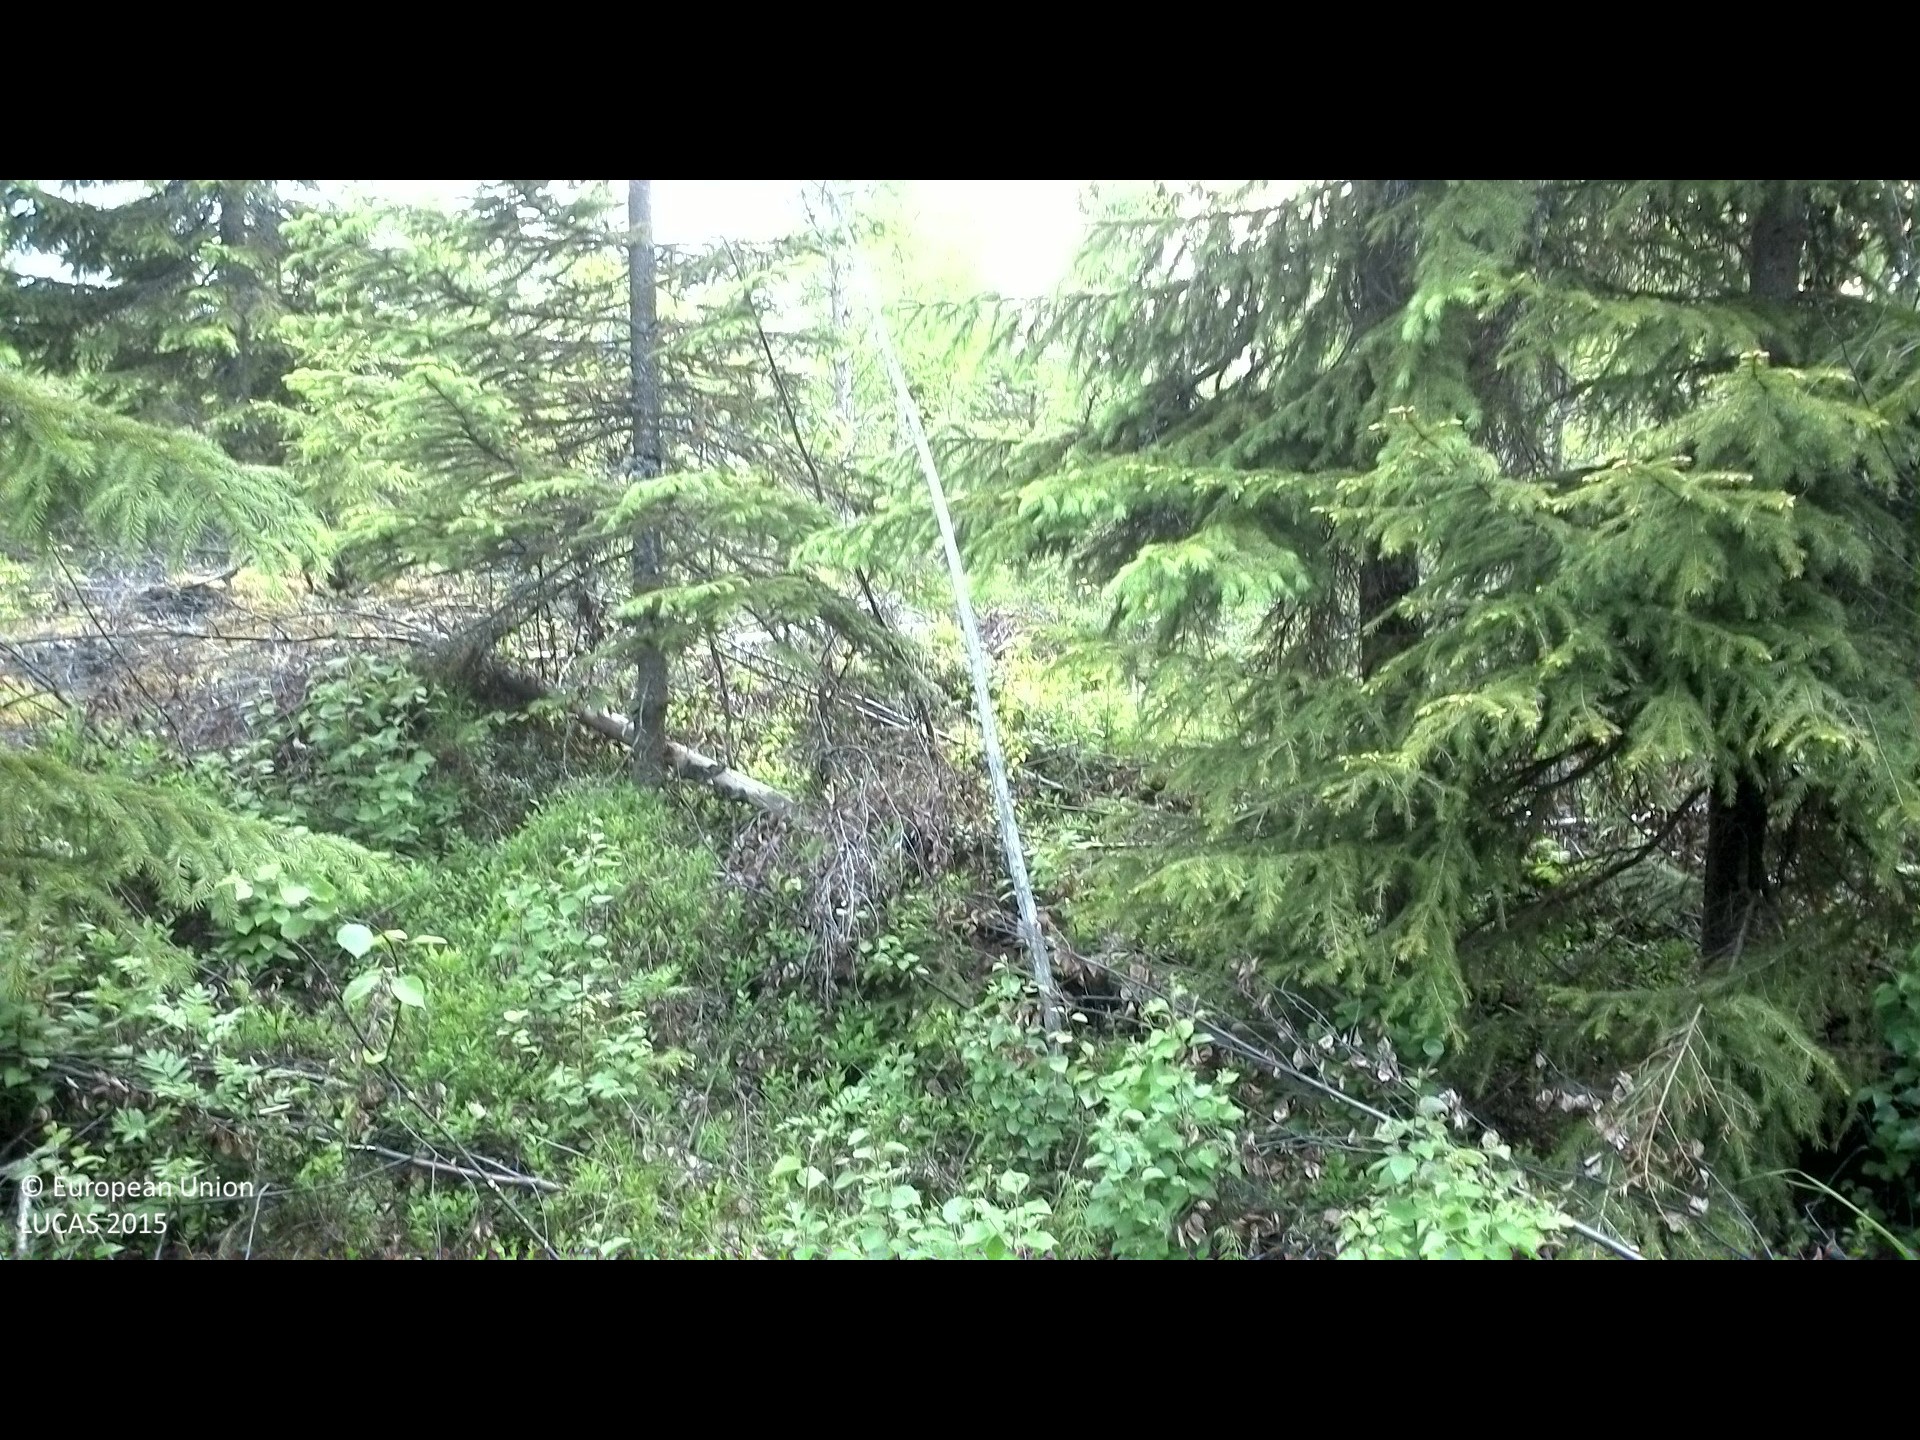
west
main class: Woodland
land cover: Spruce dominated mixed woodland
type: boreal forest
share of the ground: 25 - 50 %
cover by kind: lichens and mosses 40 %, shrubs 25 %, coniferous forest trees 15 %, broadleaved forest trees 10 %, herbaceous plants 10 %
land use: Forestry
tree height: > 5 m
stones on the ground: < 10 %
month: June
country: SE
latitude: 62.2051
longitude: 17.1900
